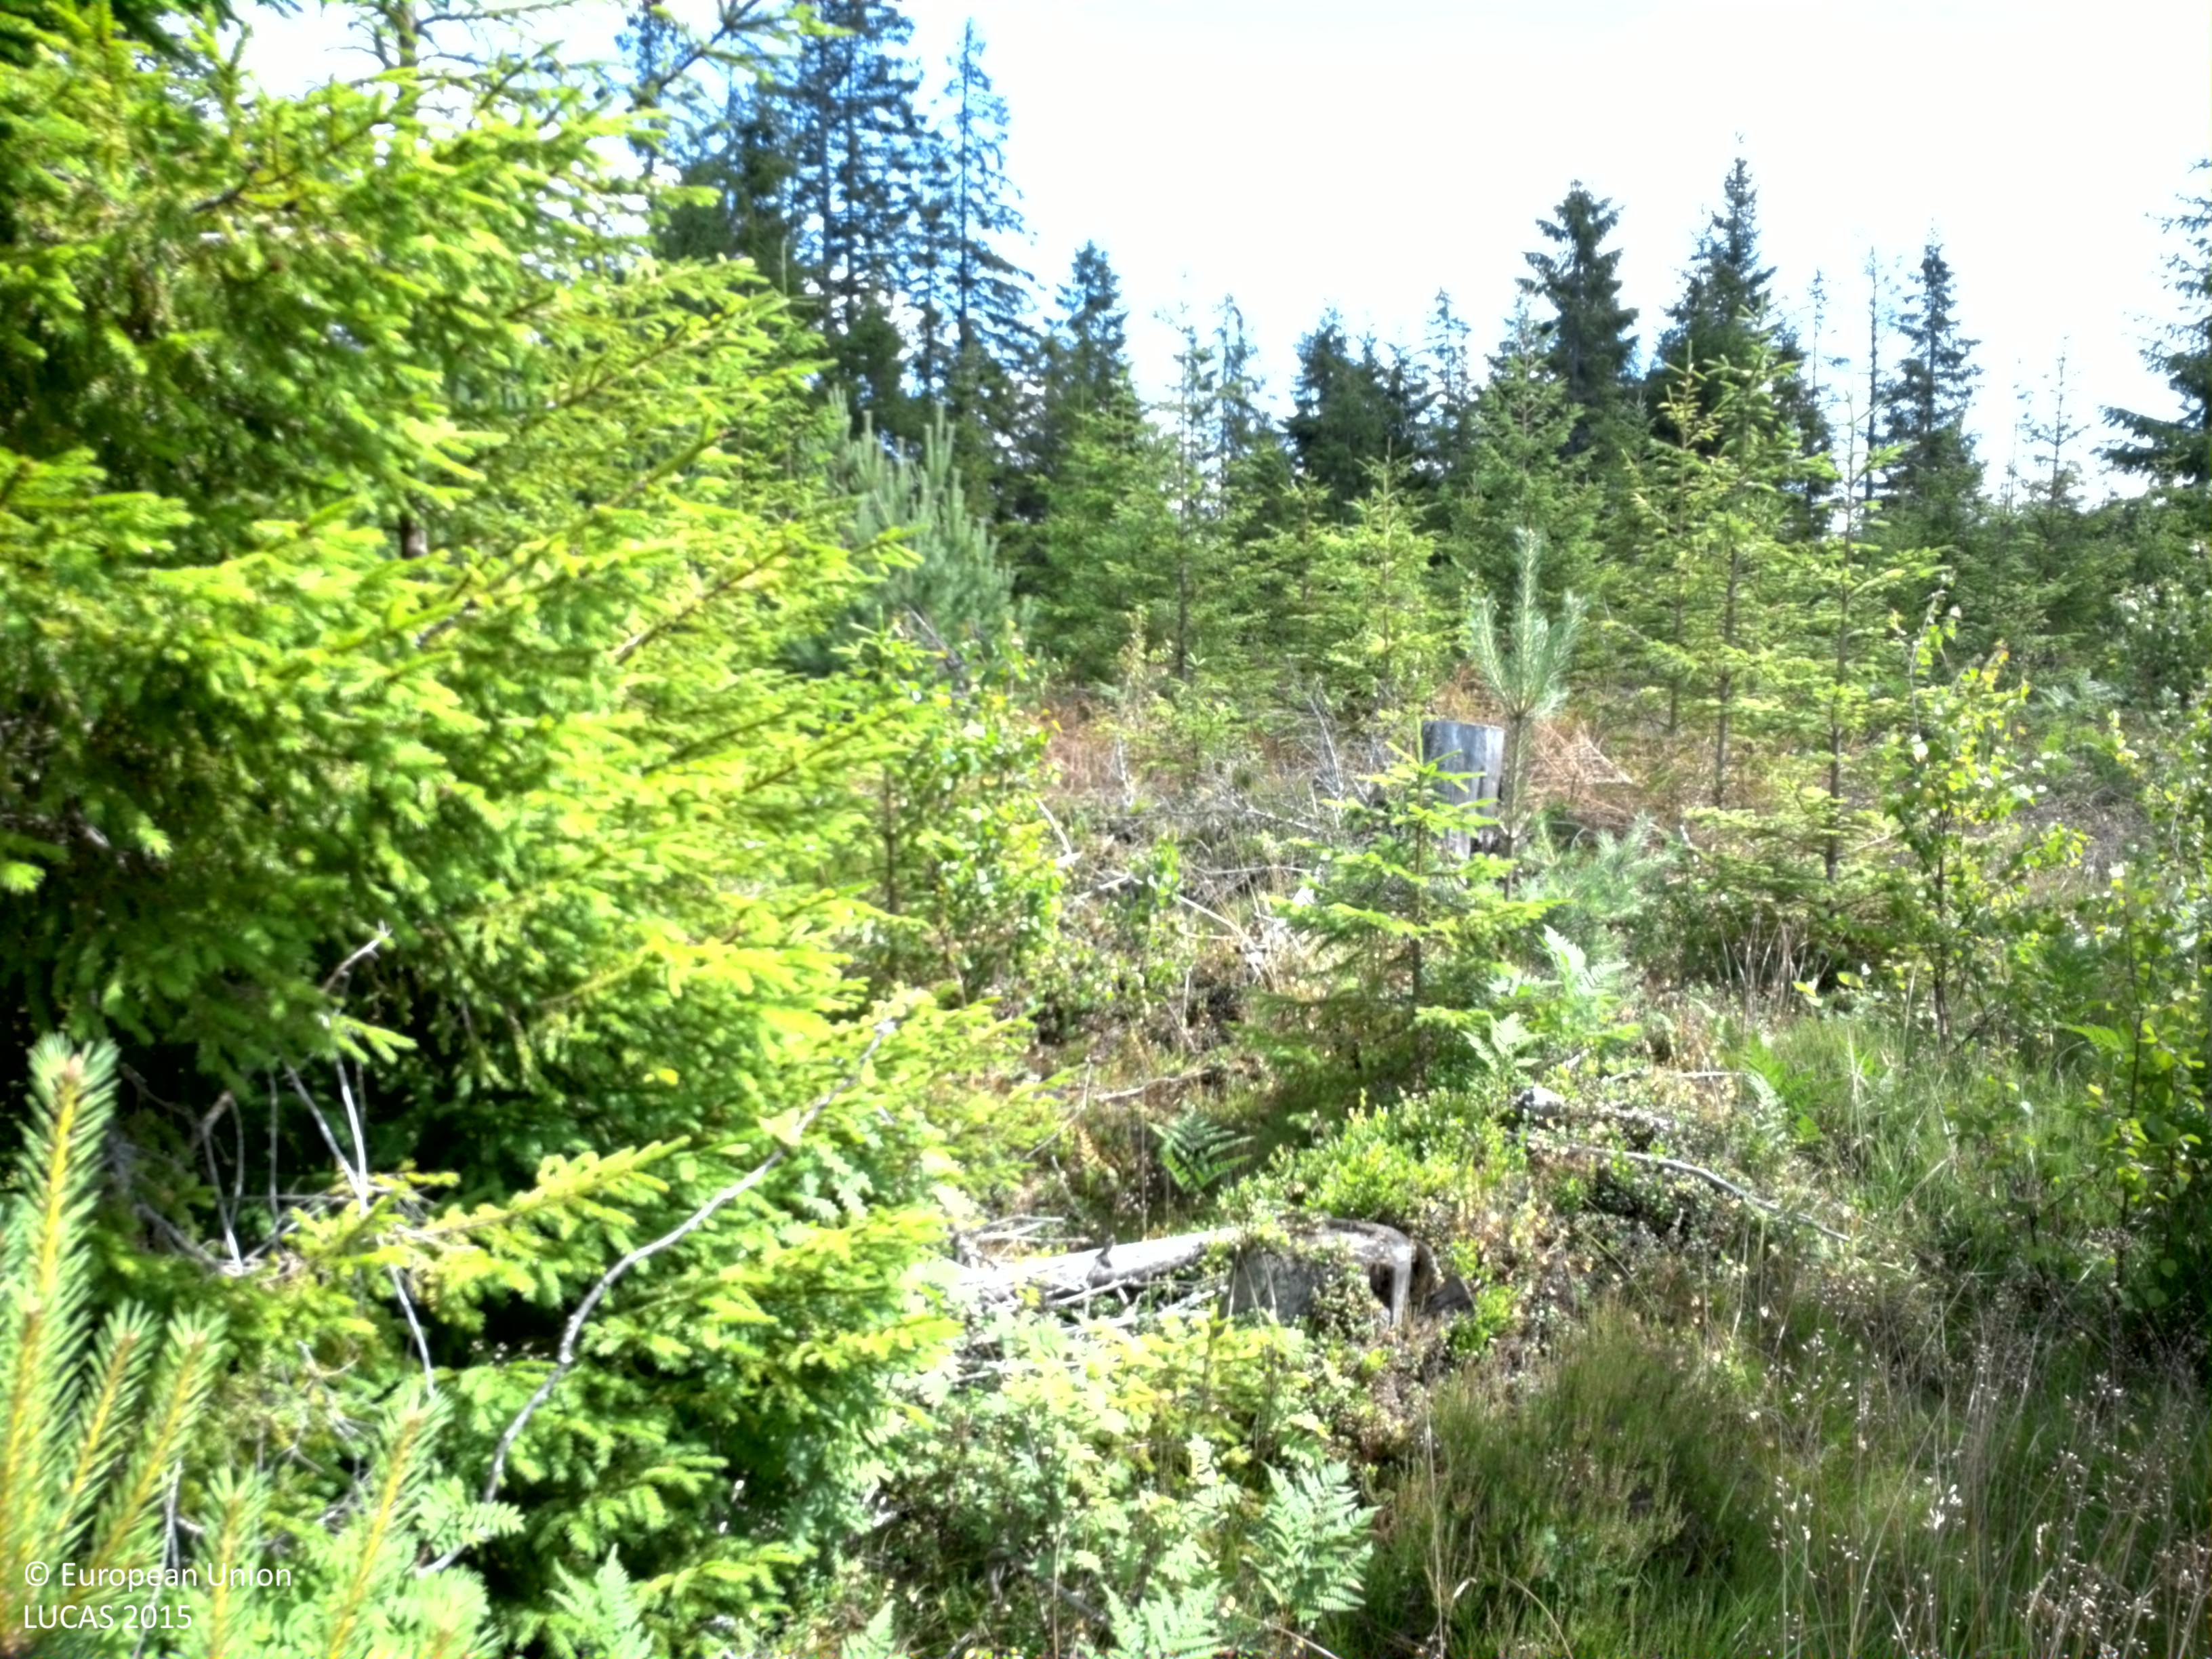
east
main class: Woodland
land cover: Other mixed woodland
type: boreal forest
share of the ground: 50 - 75 %
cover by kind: coniferous forest trees 40 %, broadleaved forest trees 20 %, herbaceous plants 20 %, shrubs 10 %, lichens and mosses 10 %
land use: Forestry
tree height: < 5 m
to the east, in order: Other mixed woodland; Spruce dominated coniferous woodland; Pine dominated coniferous woodland; Peatbogs
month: July
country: SE
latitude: 58.8633
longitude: 14.5527
